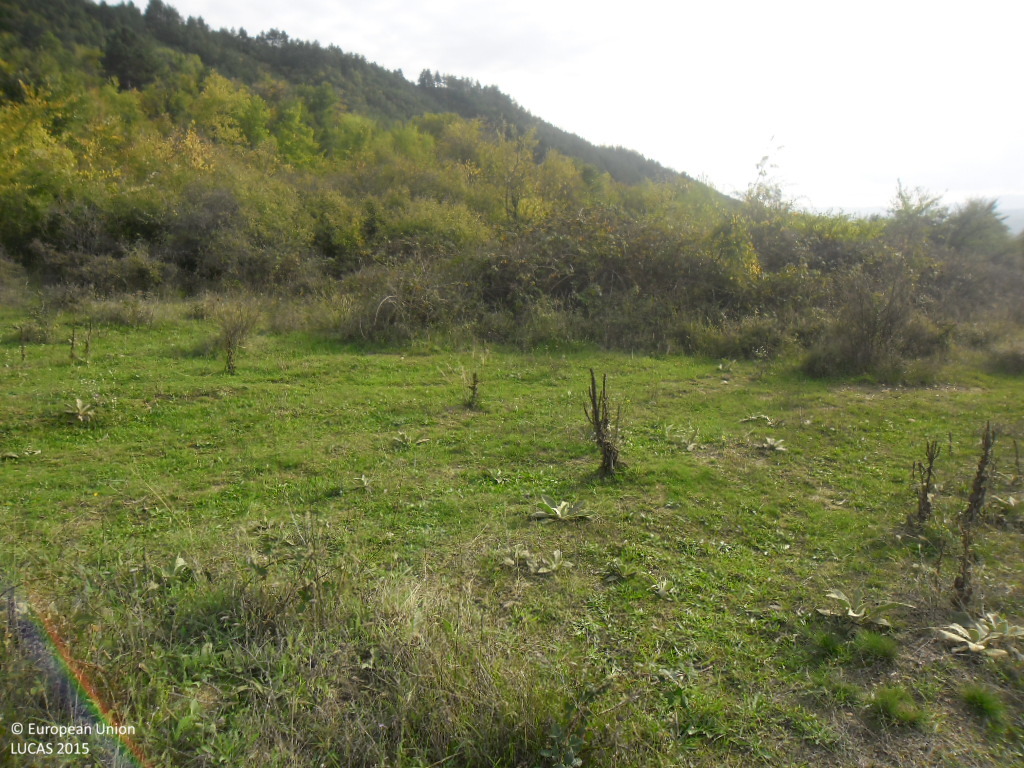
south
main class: Grassland
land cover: Grassland with sparse tree/shrub cover
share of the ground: > 75 %
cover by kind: herbaceous plants 90 %, broadleaved forest trees 5 %, shrubs 5 %
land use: Agriculture (excluding fallow land and kitchen gardens)
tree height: < 5 m
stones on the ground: < 10 %
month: October
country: BG
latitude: 42.0985
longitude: 23.0469
